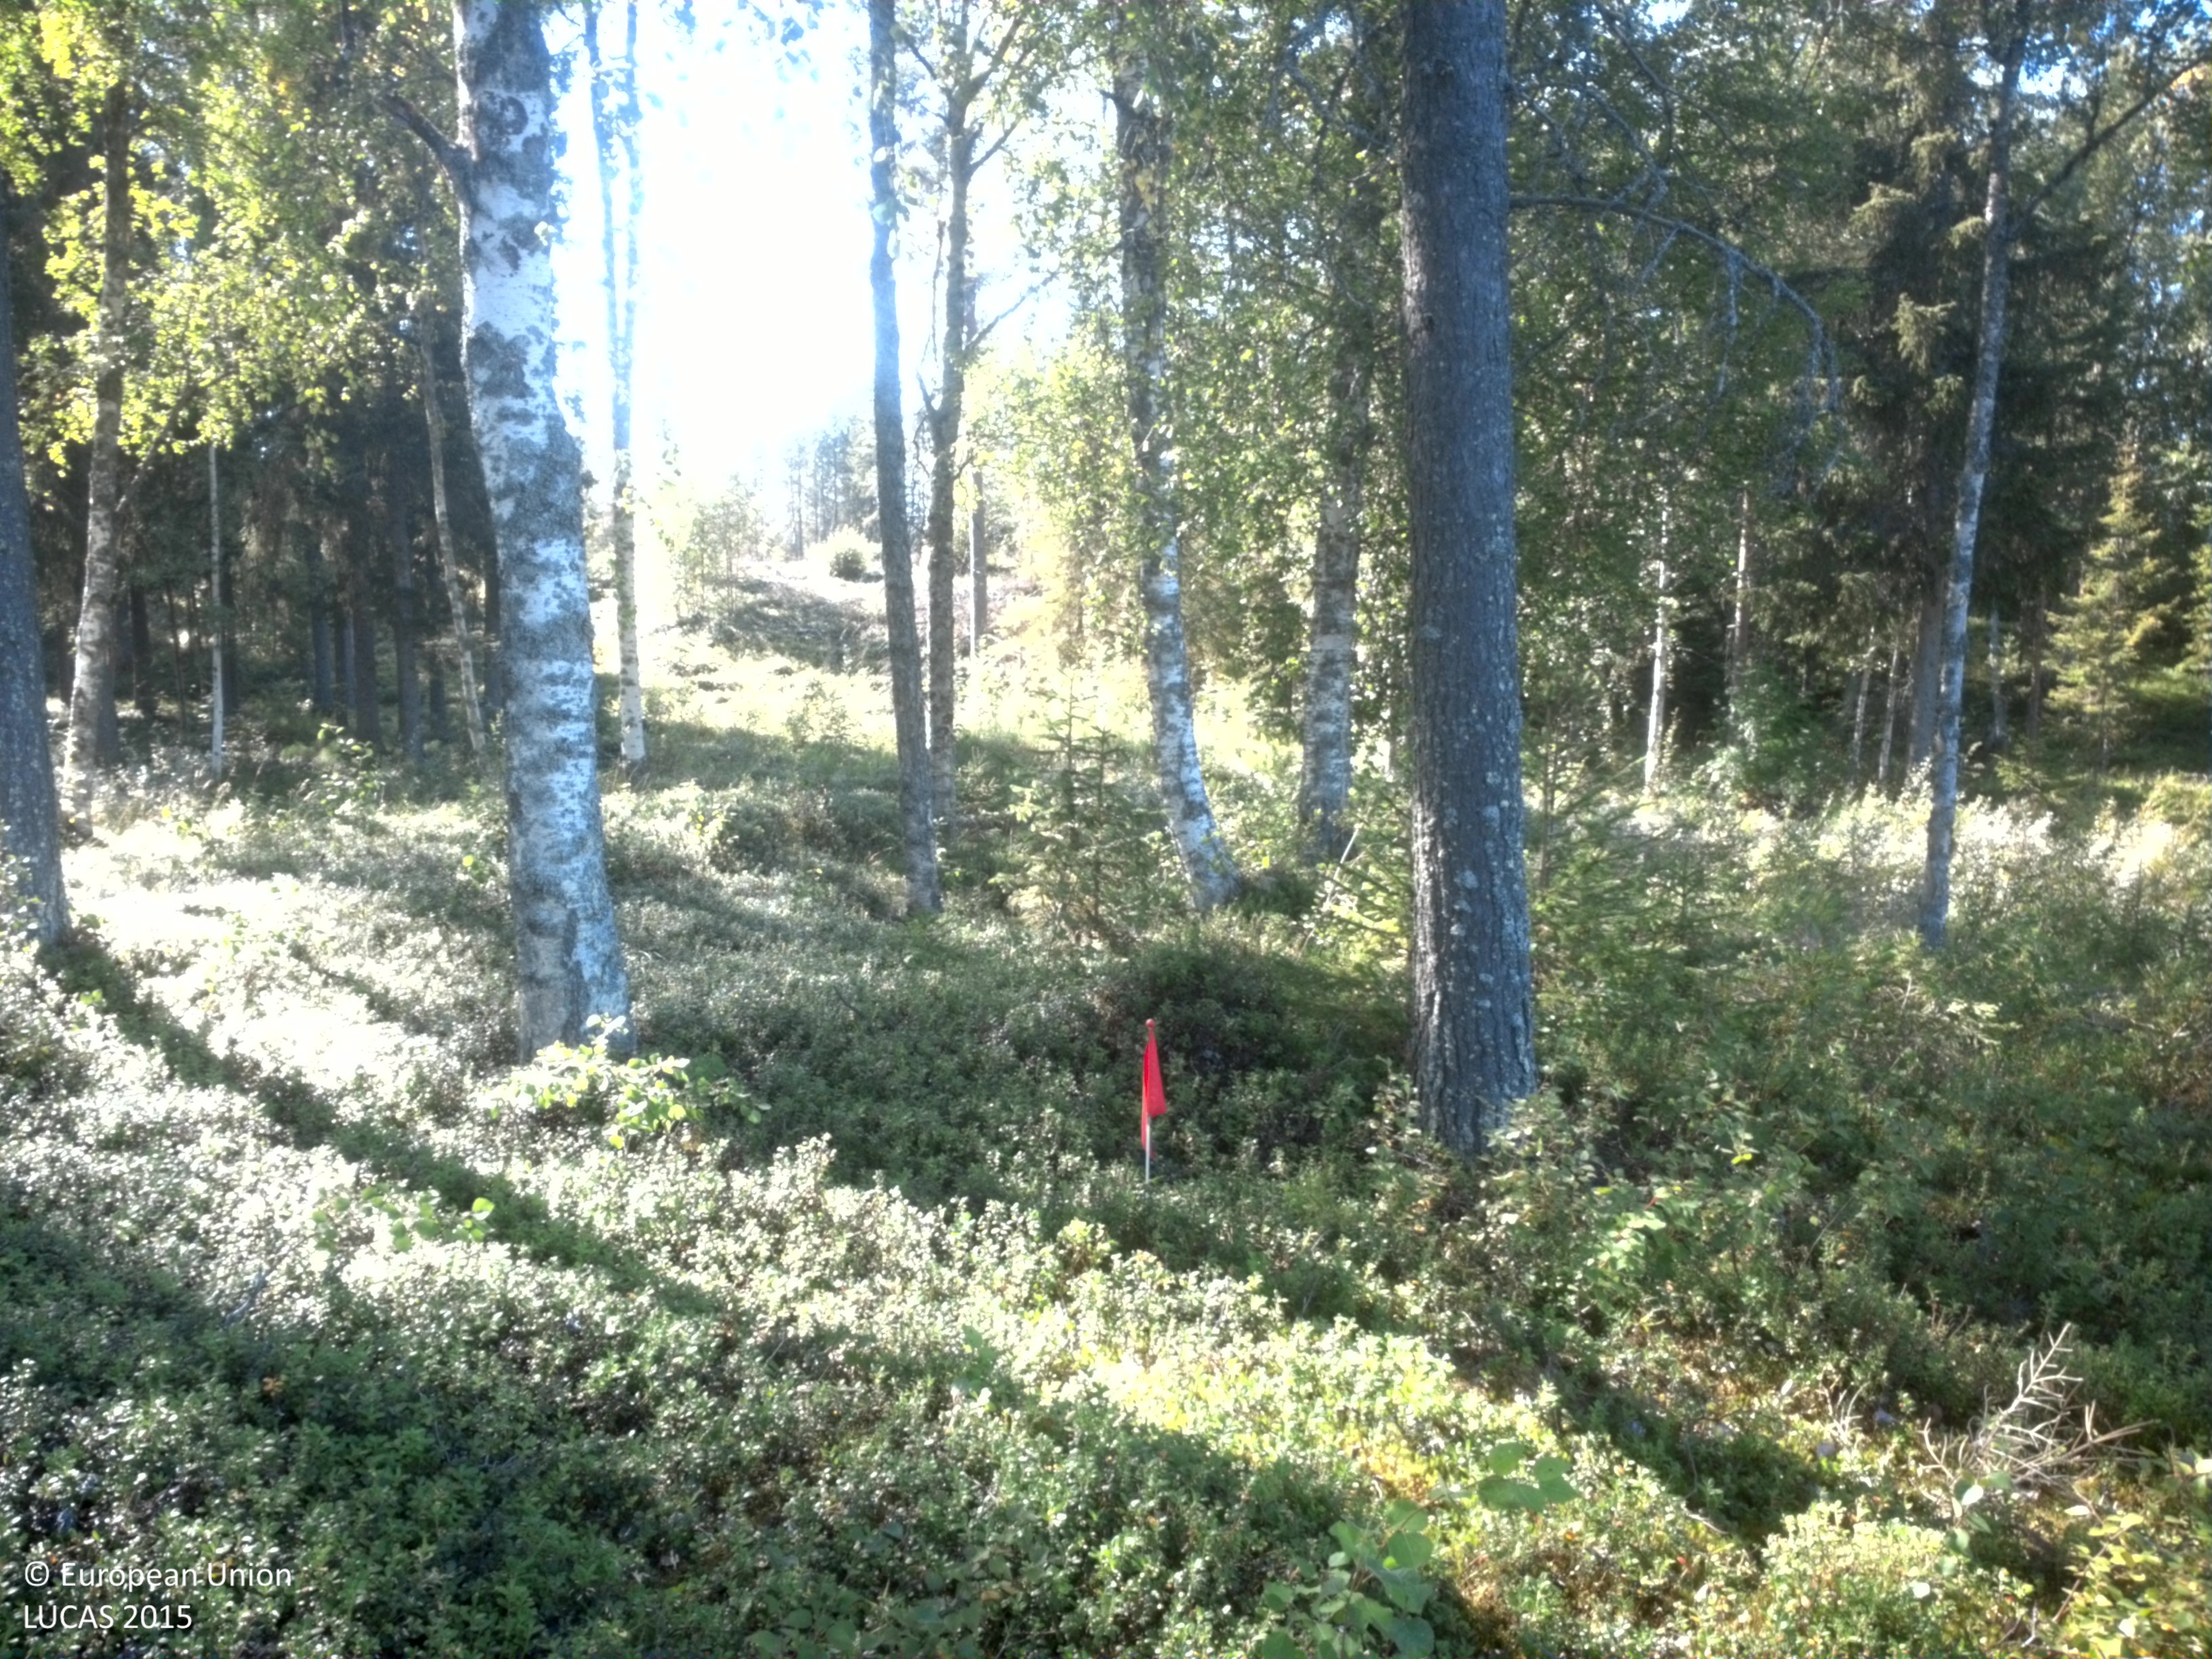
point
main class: Woodland
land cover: Pine dominated mixed woodland
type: boreal forest
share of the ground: 50 - 75 %
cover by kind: coniferous forest trees 45 %, shrubs 35 %, broadleaved forest trees 15 %, lichens and mosses 5 %
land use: Forestry
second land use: Amenities, museums, leisure
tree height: > 5 m
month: August
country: SE
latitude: 64.7106
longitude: 18.9262
